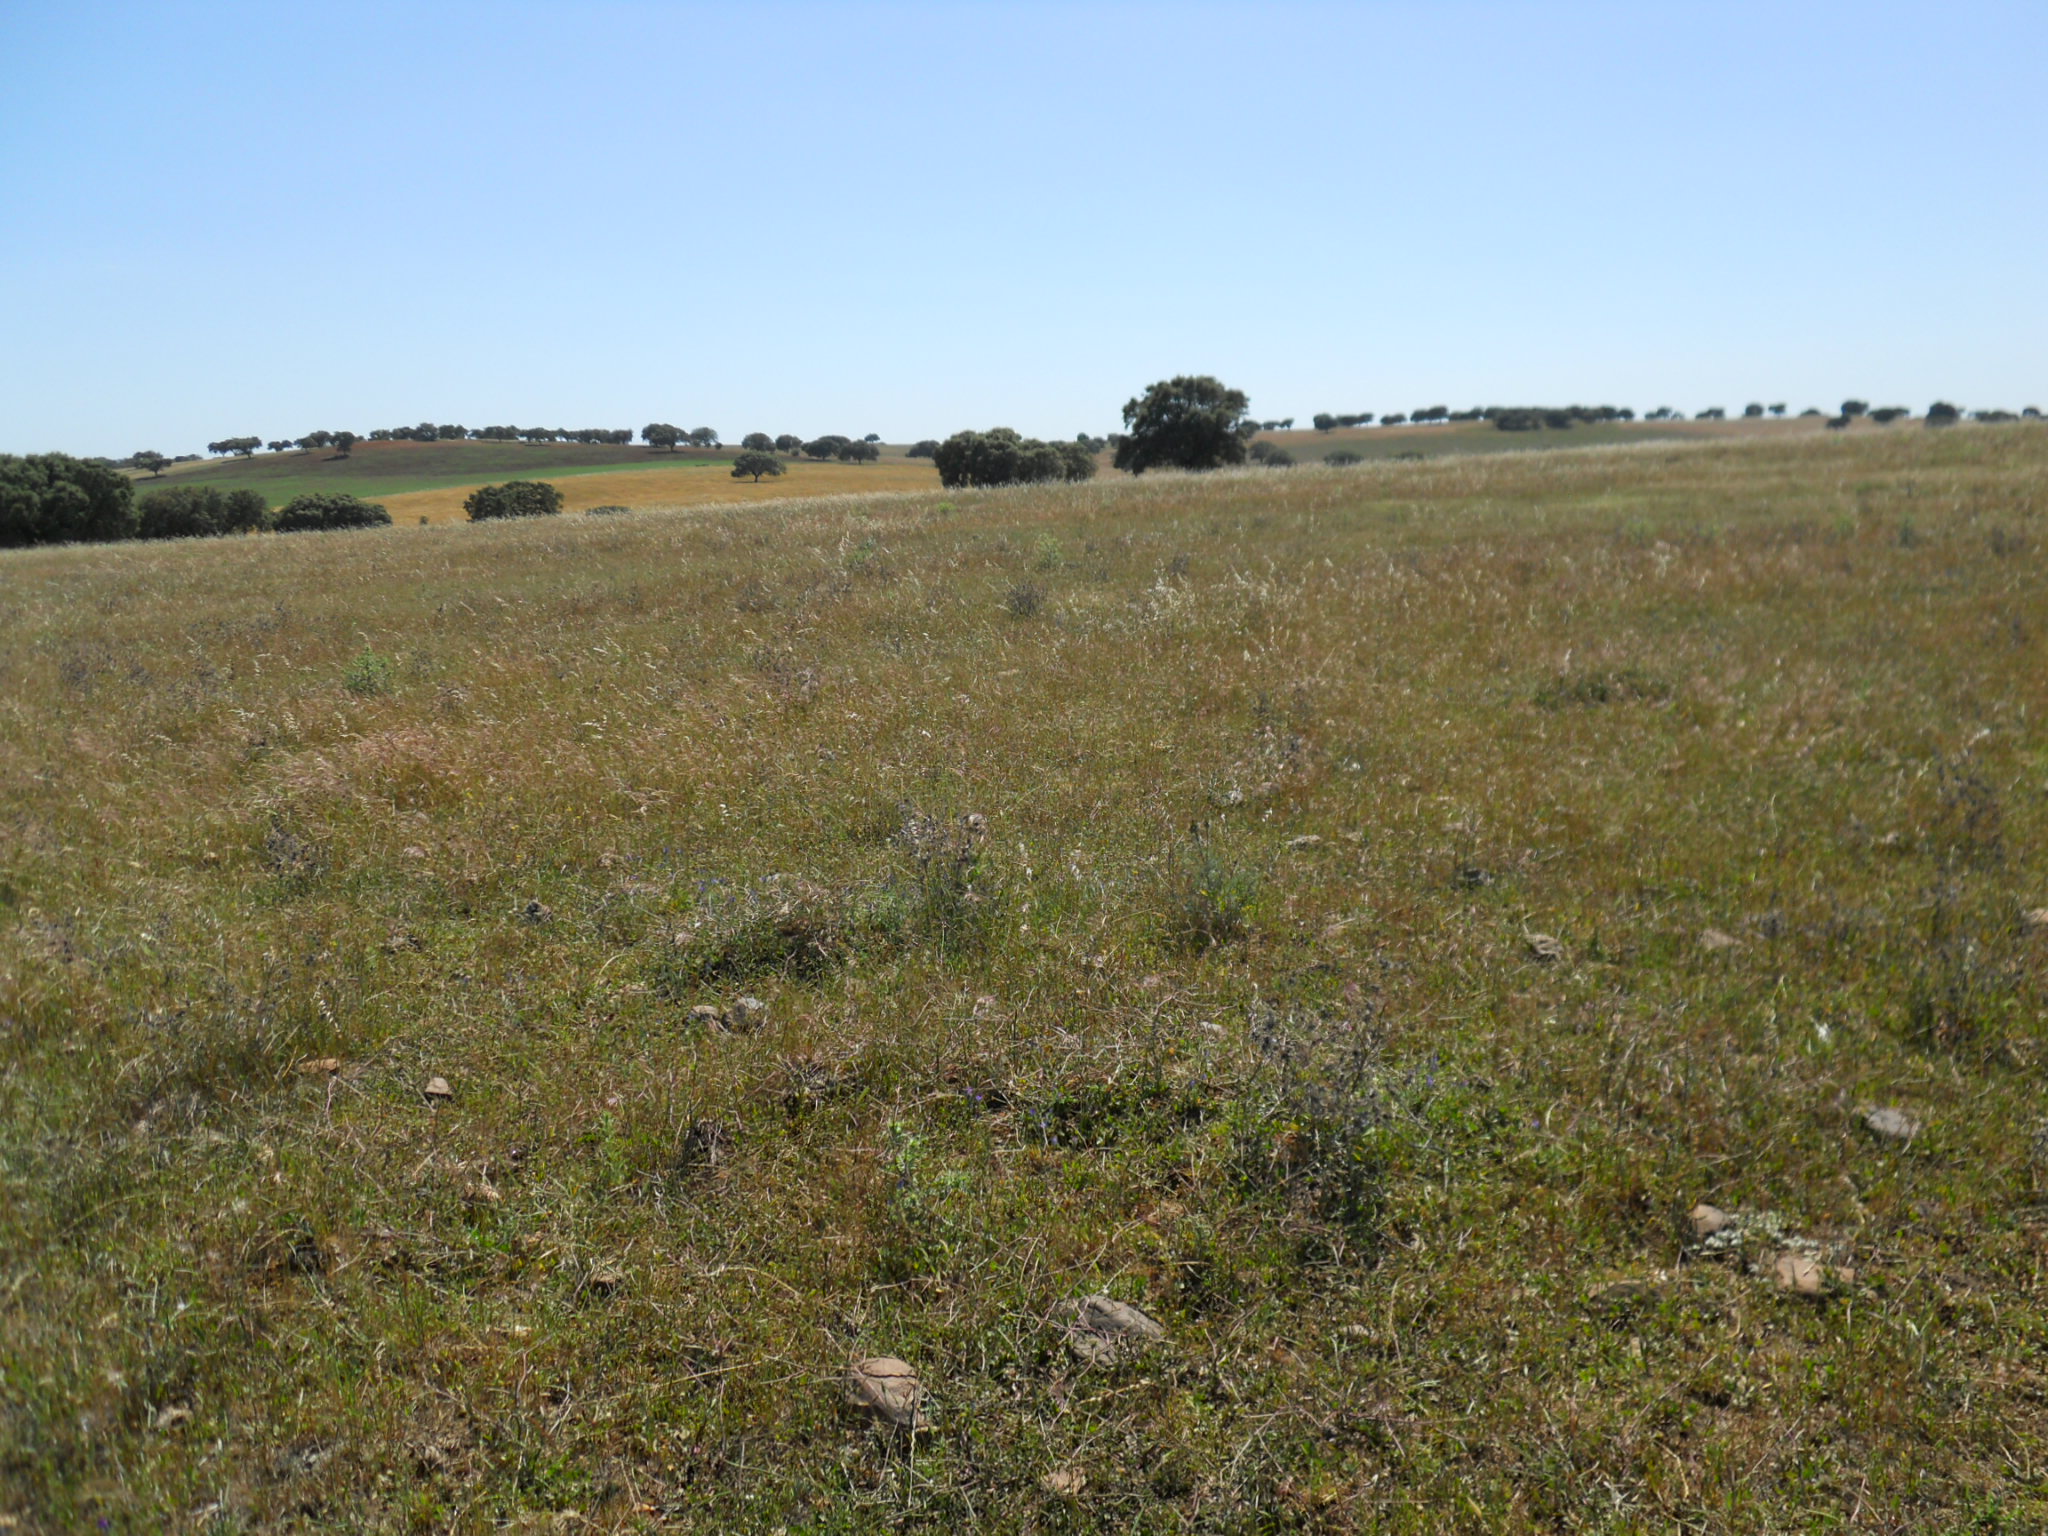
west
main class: Grassland
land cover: Grassland without tree/shrub cover
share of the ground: > 75 %
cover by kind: herbaceous plants 100 %
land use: Agriculture (excluding fallow land and kitchen gardens)
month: May
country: ES
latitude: 39.0665
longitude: -6.5808
